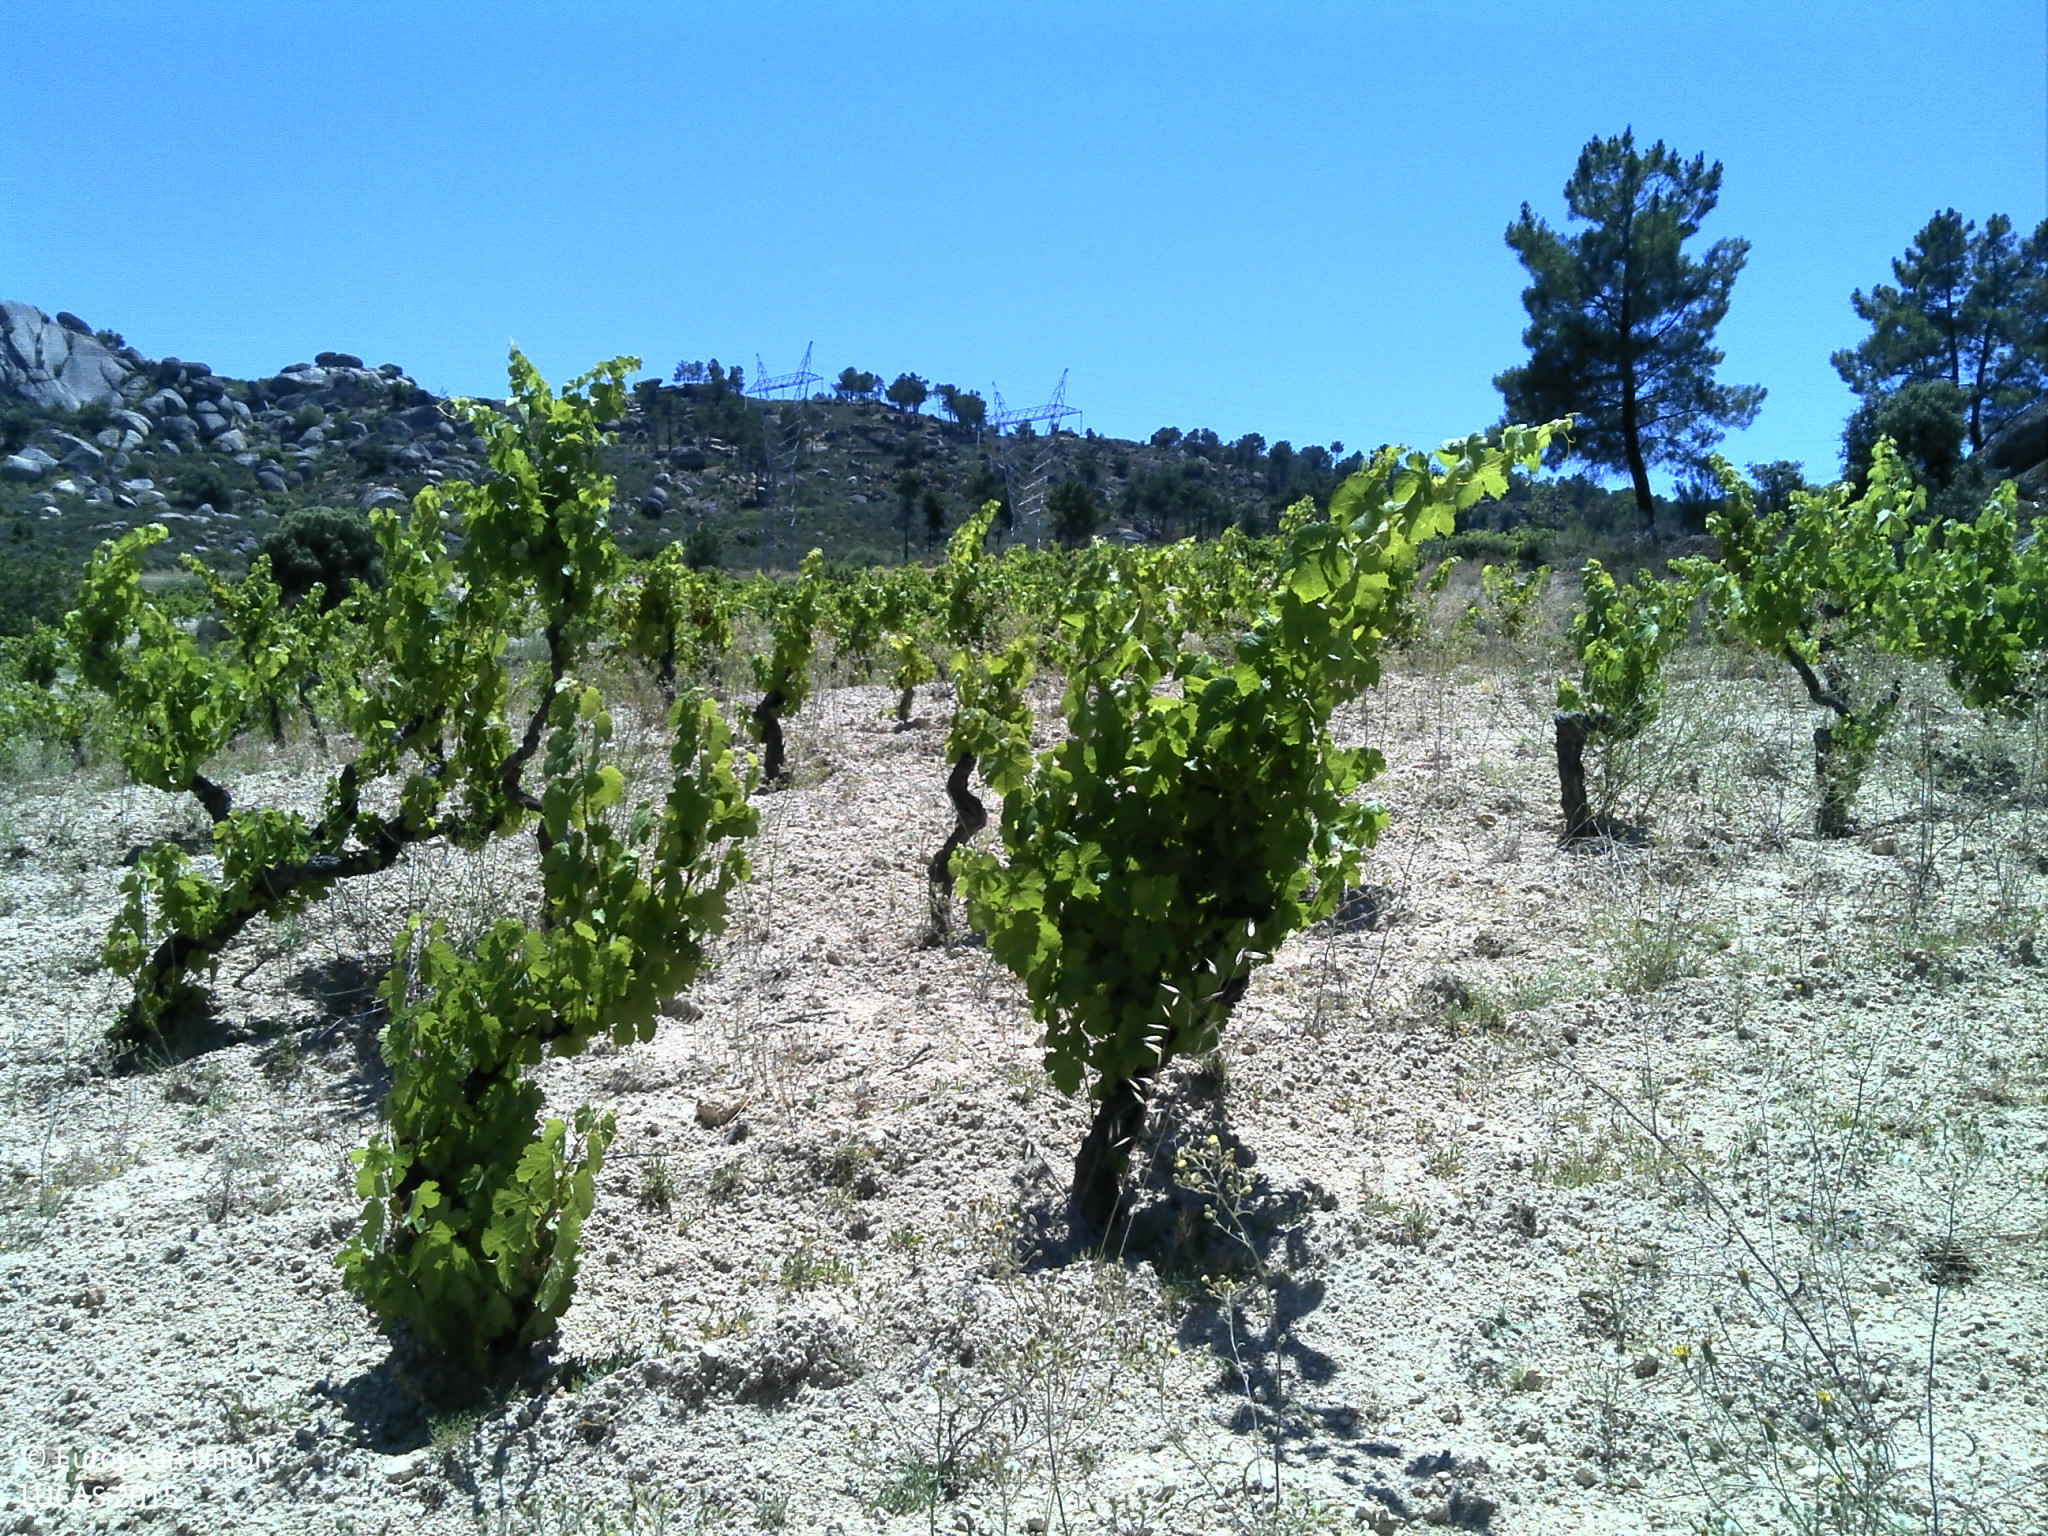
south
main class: Cropland
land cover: Vineyards
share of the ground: 10 - 25 %
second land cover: Grassland without tree/shrub cover
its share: 10 - 25 %
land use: Agriculture (excluding fallow land and kitchen gardens)
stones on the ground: > 50 %
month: June
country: PT
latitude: 40.8826
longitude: -7.2598
